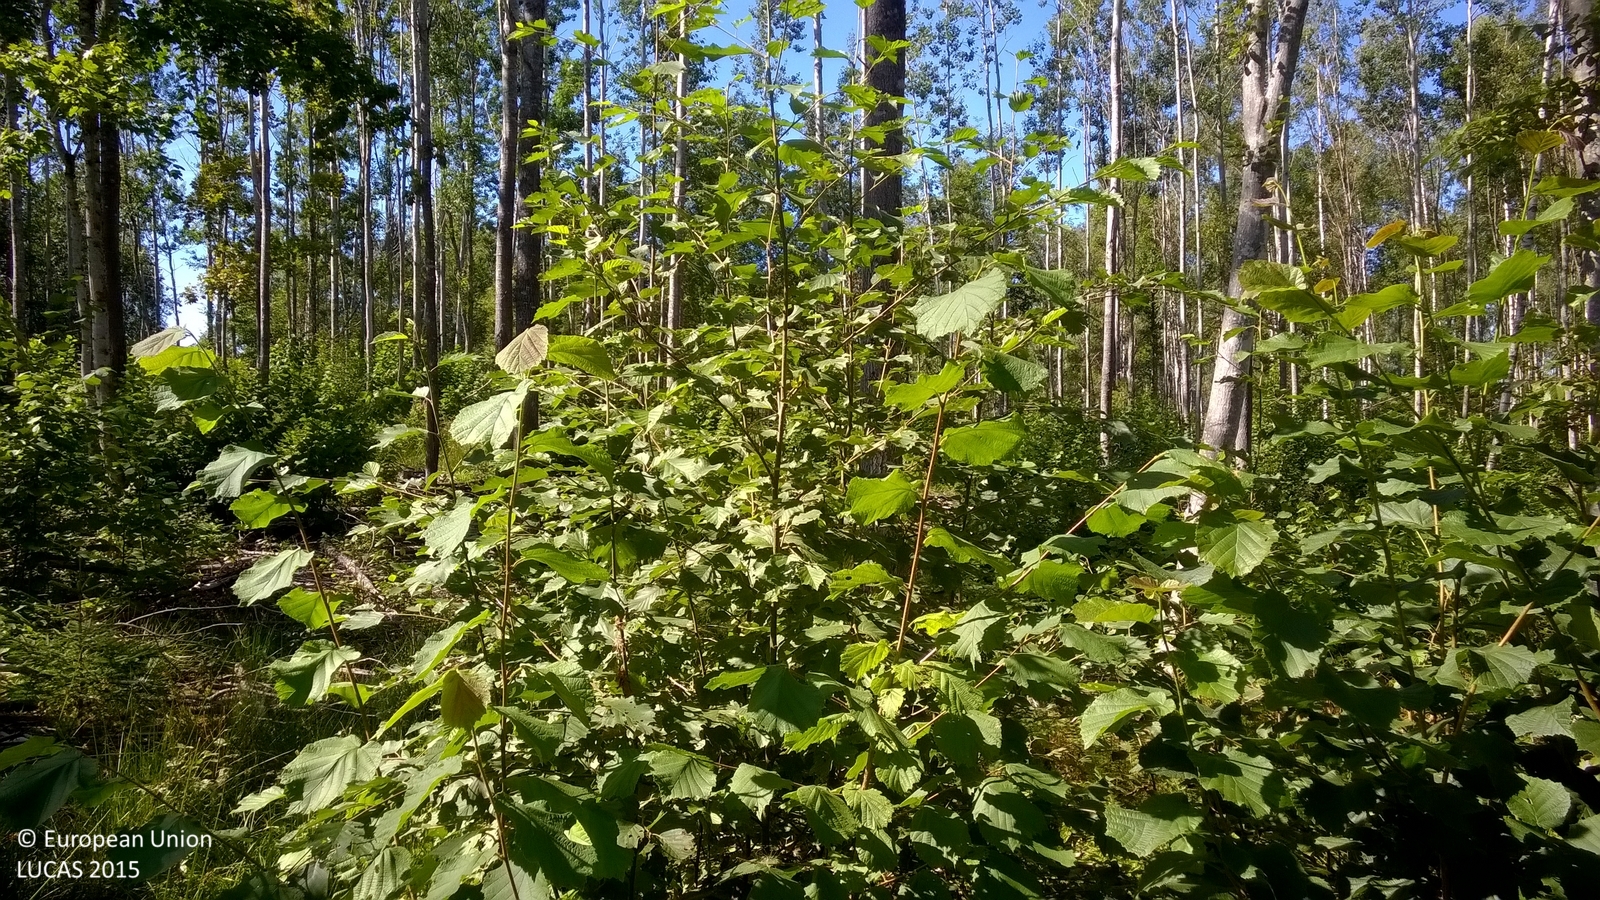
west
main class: Woodland
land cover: Broadleaved woodland
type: non-riverine alder, birch or aspen forest
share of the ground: > 75 %
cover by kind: broadleaved forest trees 80 %, shrubs 10 %, herbaceous plants 10 %
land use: Forestry
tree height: > 5 m
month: August
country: LV
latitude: 57.2452
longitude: 25.4440
